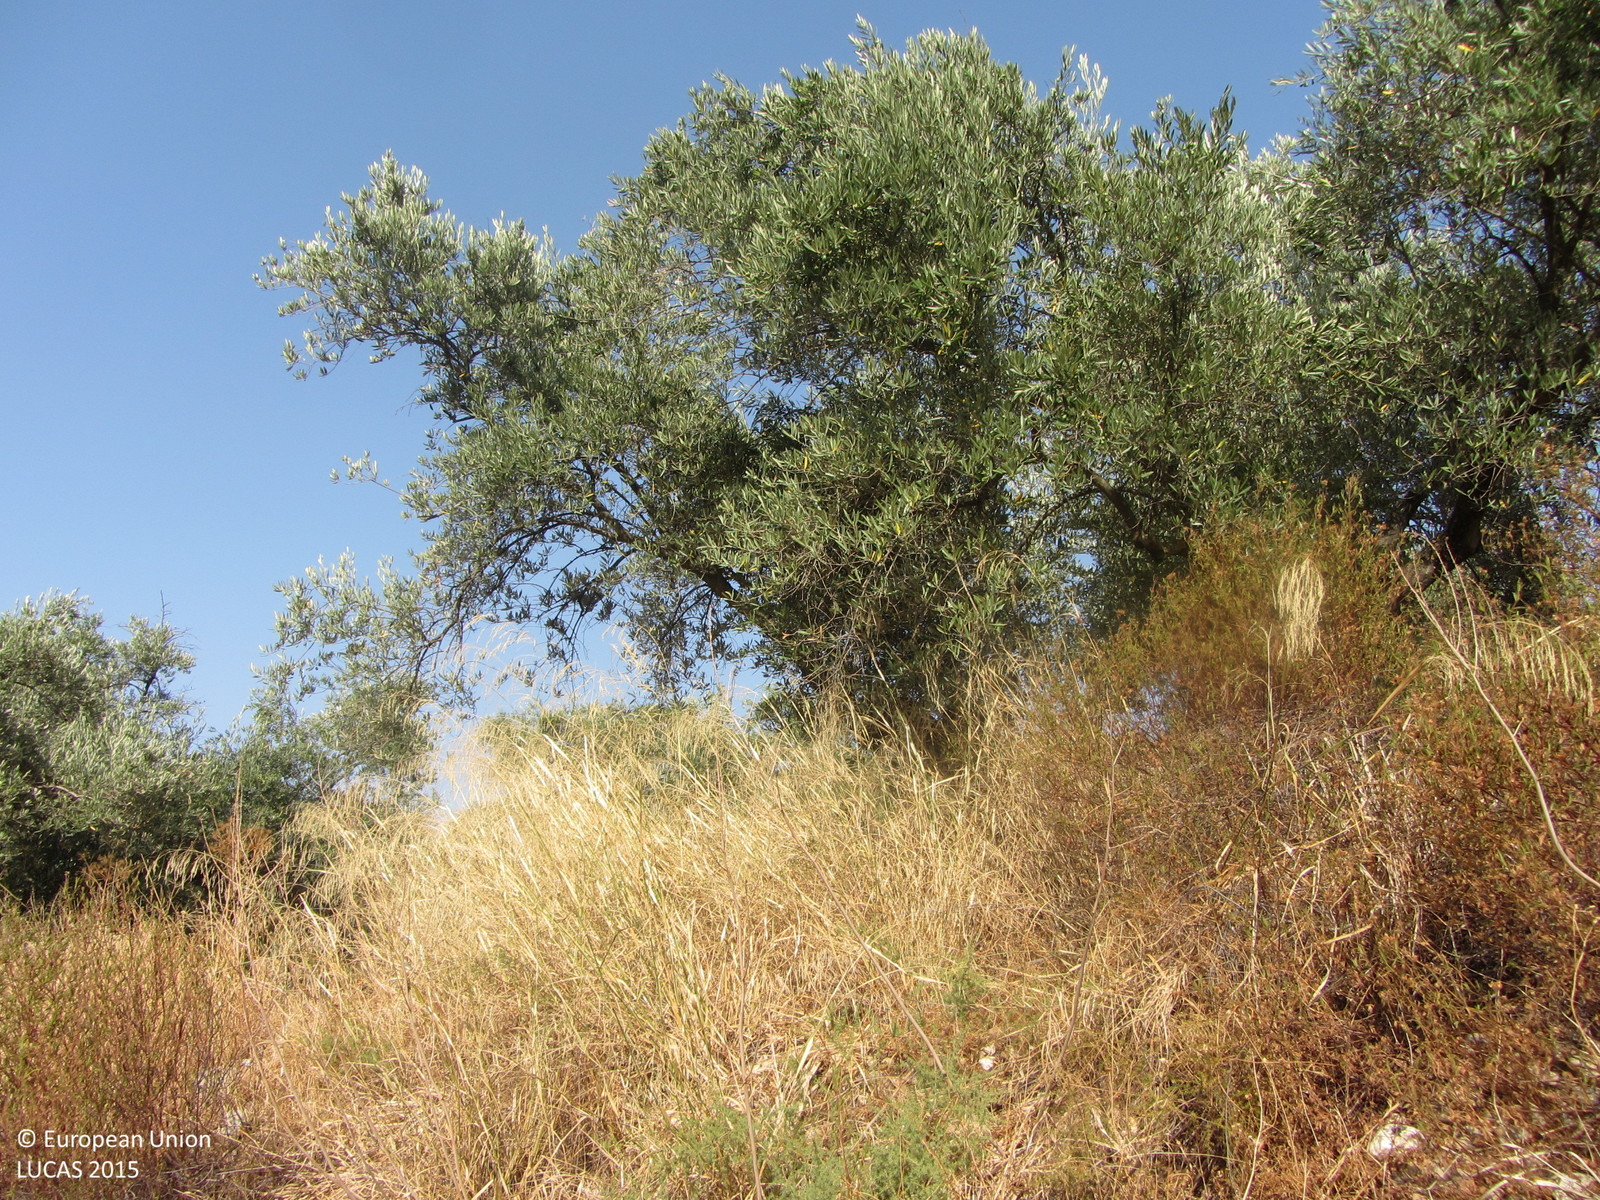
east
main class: Cropland
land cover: Olive groves
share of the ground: 25 - 50 %
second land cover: Spontaneously vegetated surfaces
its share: 50 - 75 %
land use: Agriculture (excluding fallow land and kitchen gardens)
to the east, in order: Olive groves; Spontaneously vegetated surfaces; Shruby margins; Olive groves; Tracks; Olive groves; Tracks; Olive groves
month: July
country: ES
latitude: 38.0506
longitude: -3.8515
